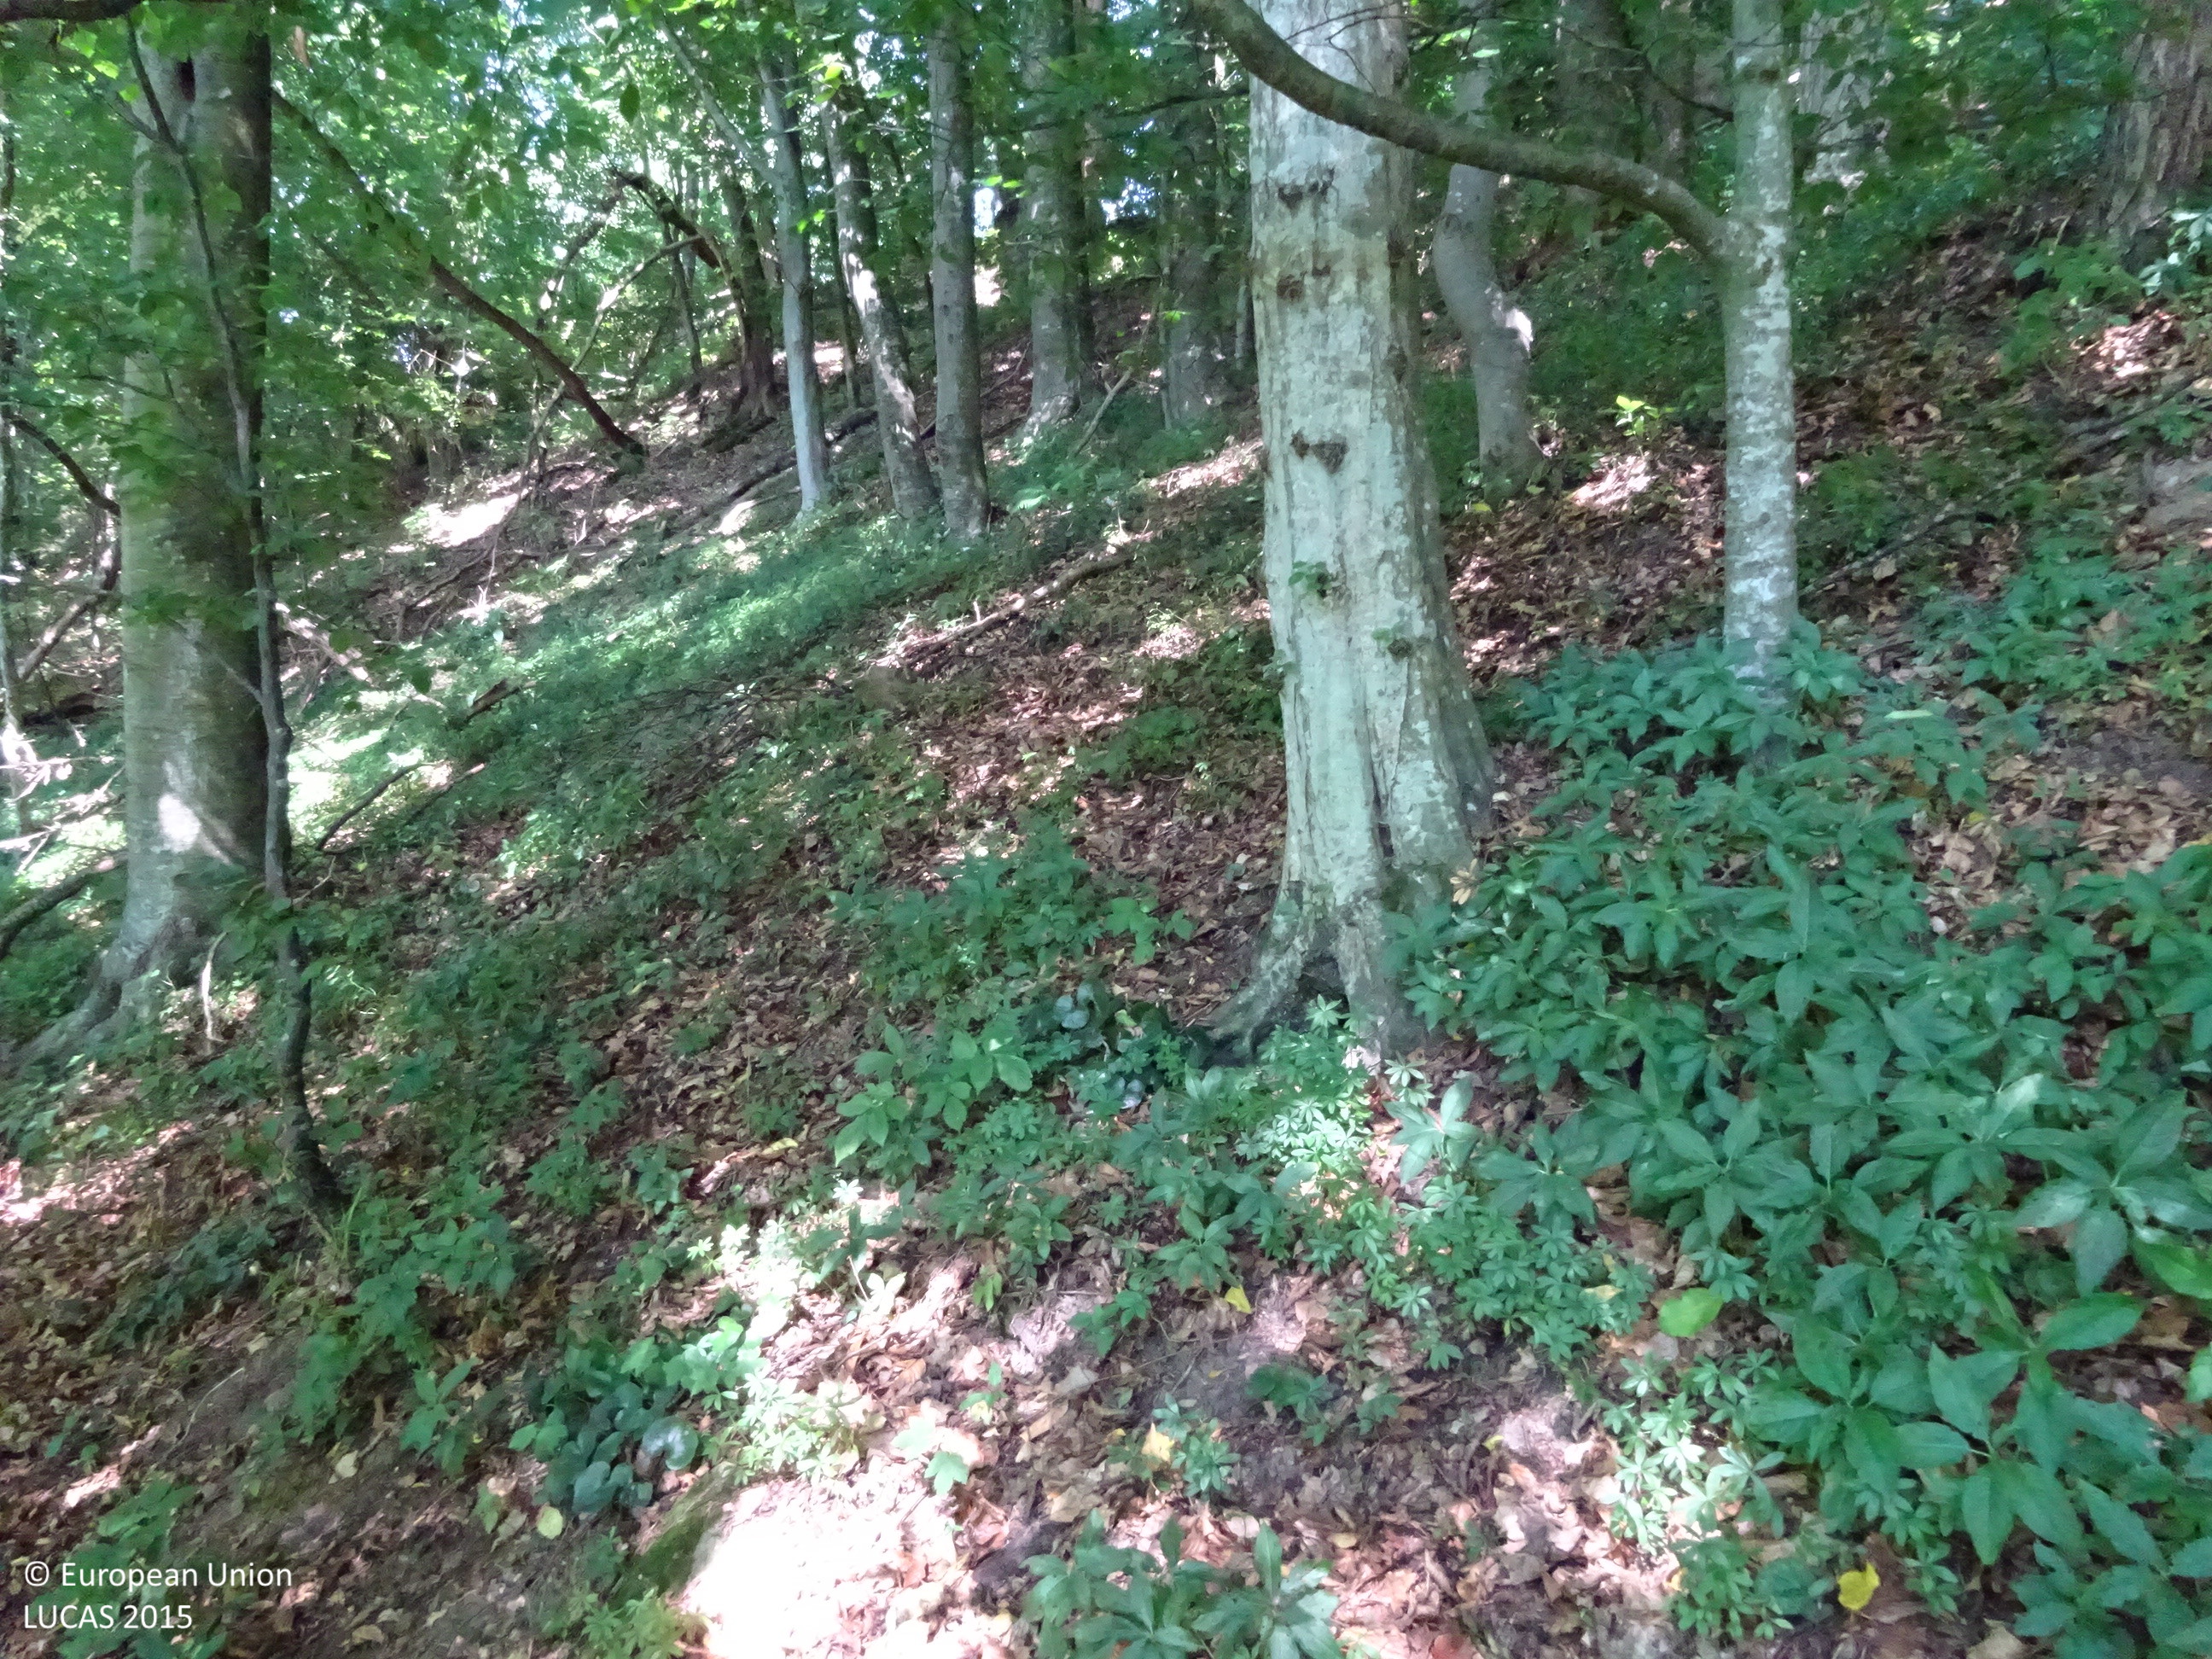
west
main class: Woodland
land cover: Broadleaved woodland
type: beech forest
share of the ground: > 75 %
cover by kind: broadleaved forest trees 100 %
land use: Forestry
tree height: > 5 m
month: August
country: AT
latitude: 47.4401
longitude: 16.1153
